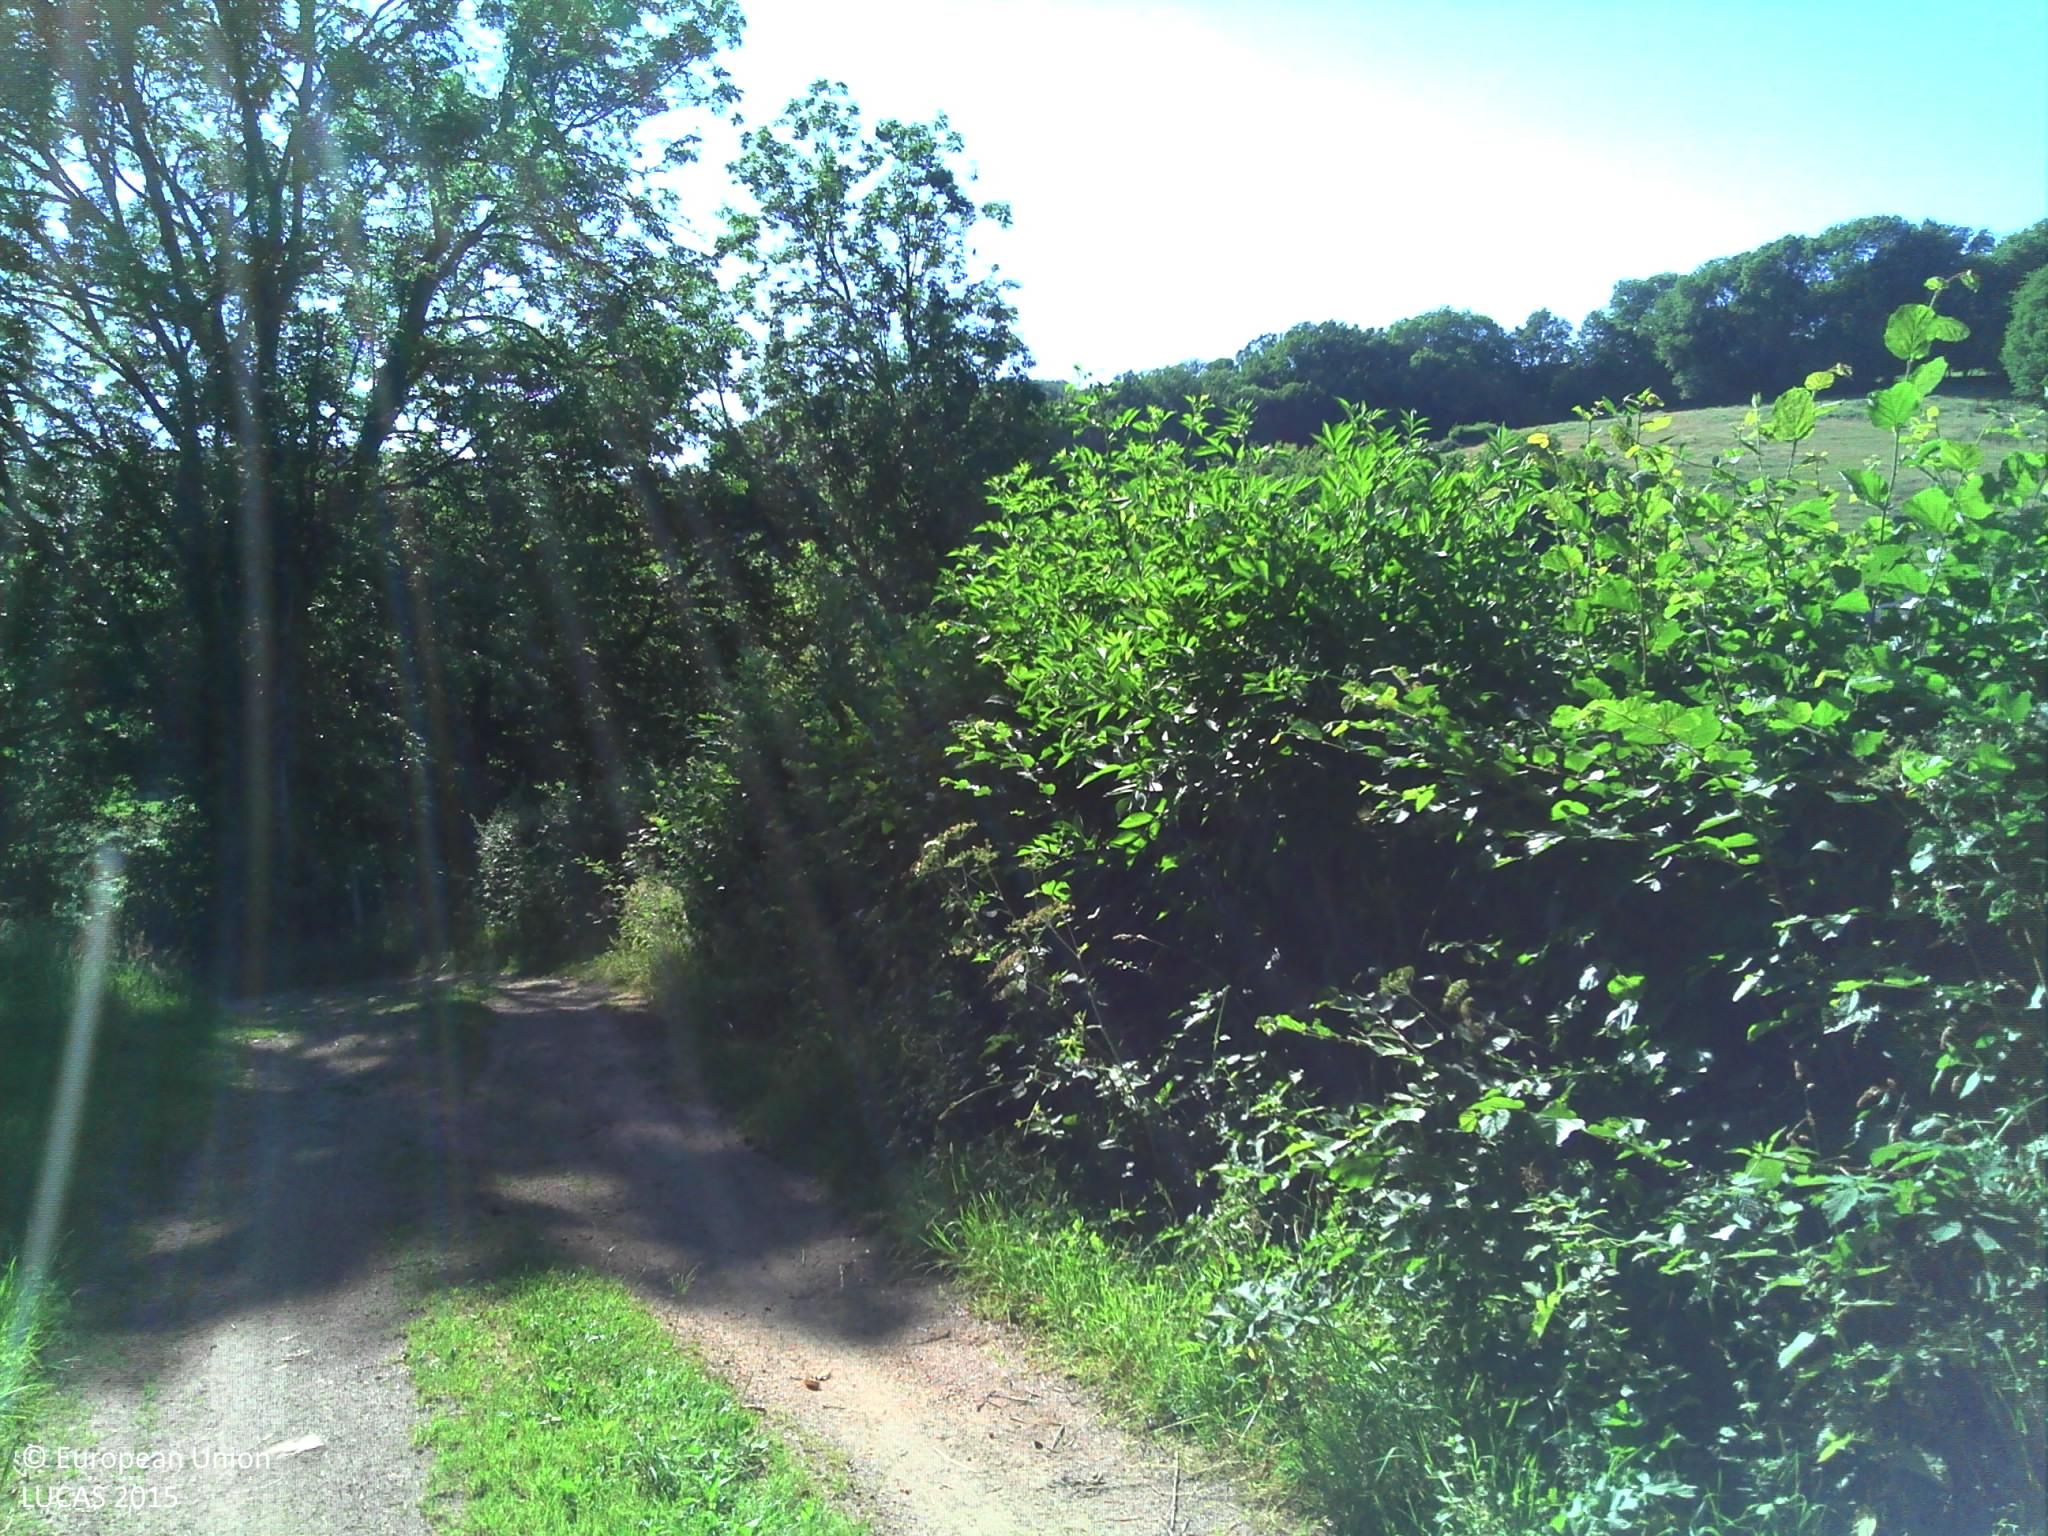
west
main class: Woodland
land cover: Broadleaved woodland
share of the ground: 50 - 75 %
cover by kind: broadleaved forest trees 60 %, herbaceous plants 40 %
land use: Residential
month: June
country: FR
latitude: 47.1711
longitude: 3.9163
